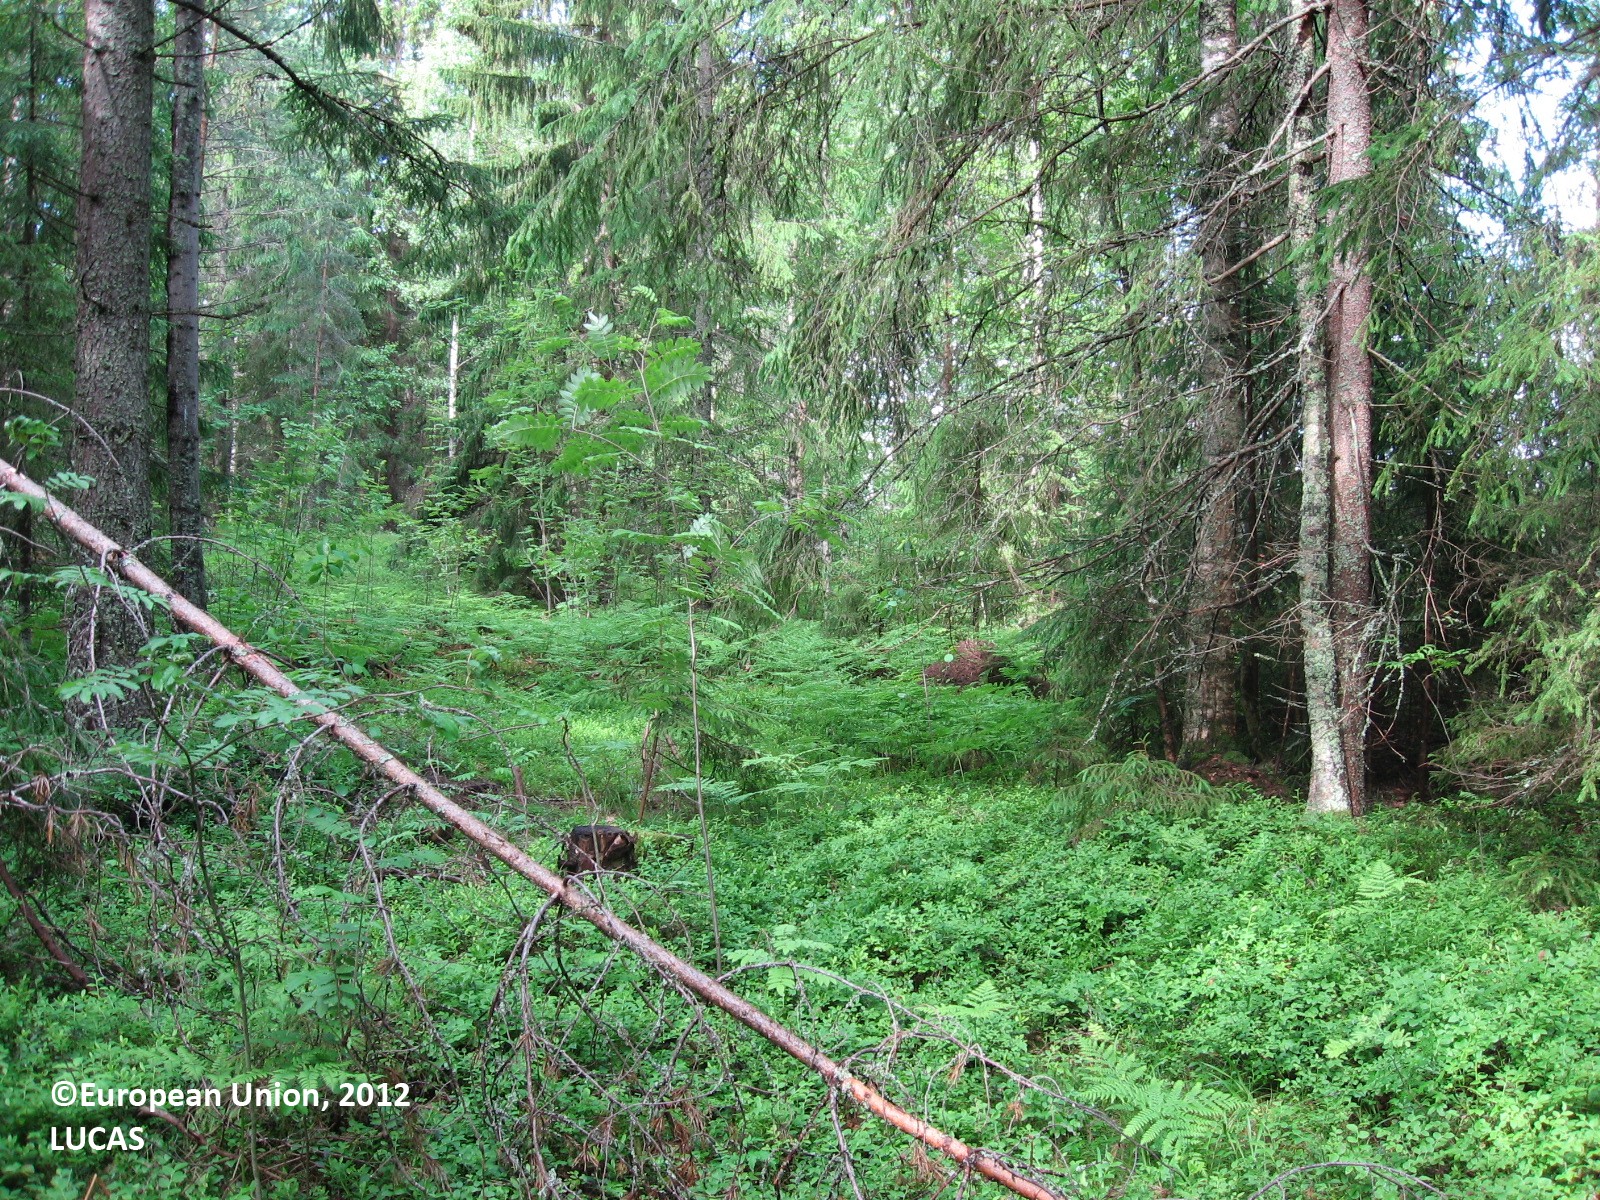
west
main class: Woodland
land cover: Spruce dominated coniferous woodland
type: boreal forest
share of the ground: 50 - 75 %
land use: Forestry
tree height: > 5 m
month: June
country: FI
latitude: 60.5706
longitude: 26.4469
